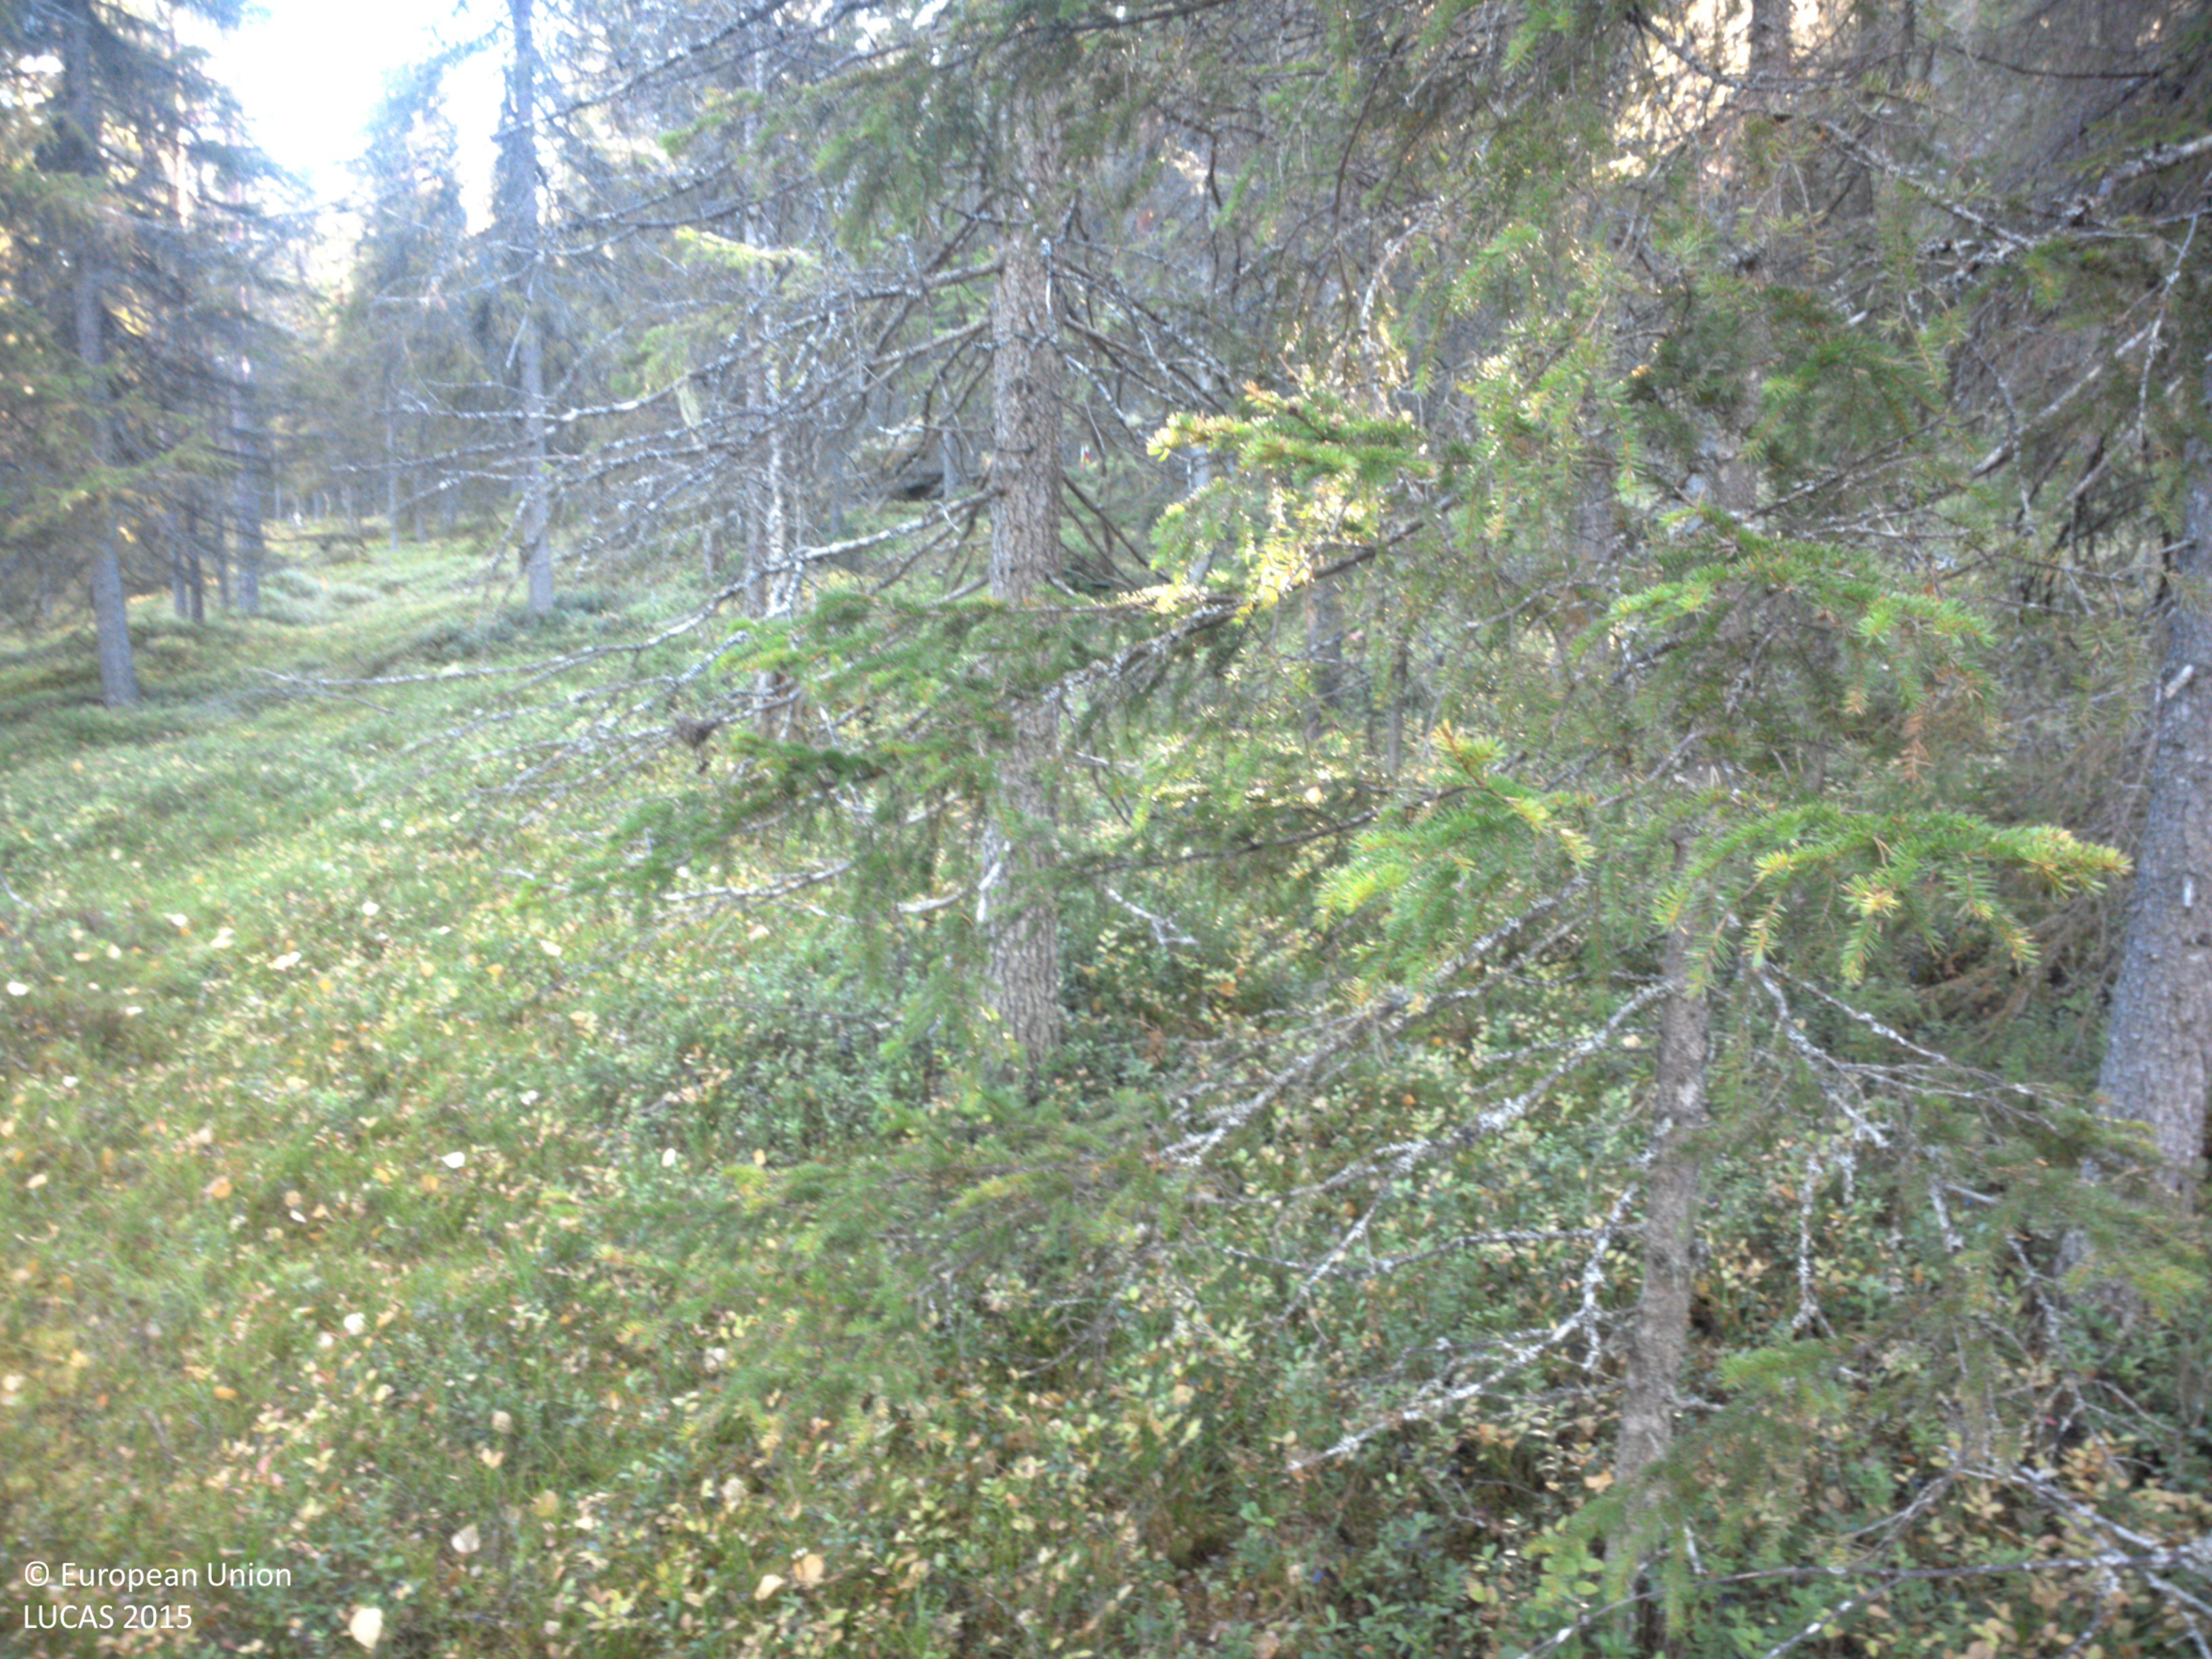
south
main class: Woodland
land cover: Other mixed woodland
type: boreal forest
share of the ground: > 75 %
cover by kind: coniferous forest trees 60 %, broadleaved forest trees 25 %, shrubs 10 %, lichens and mosses 5 %
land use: Forestry
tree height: > 5 m
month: October
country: SE
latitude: 64.7776
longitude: 18.3576
